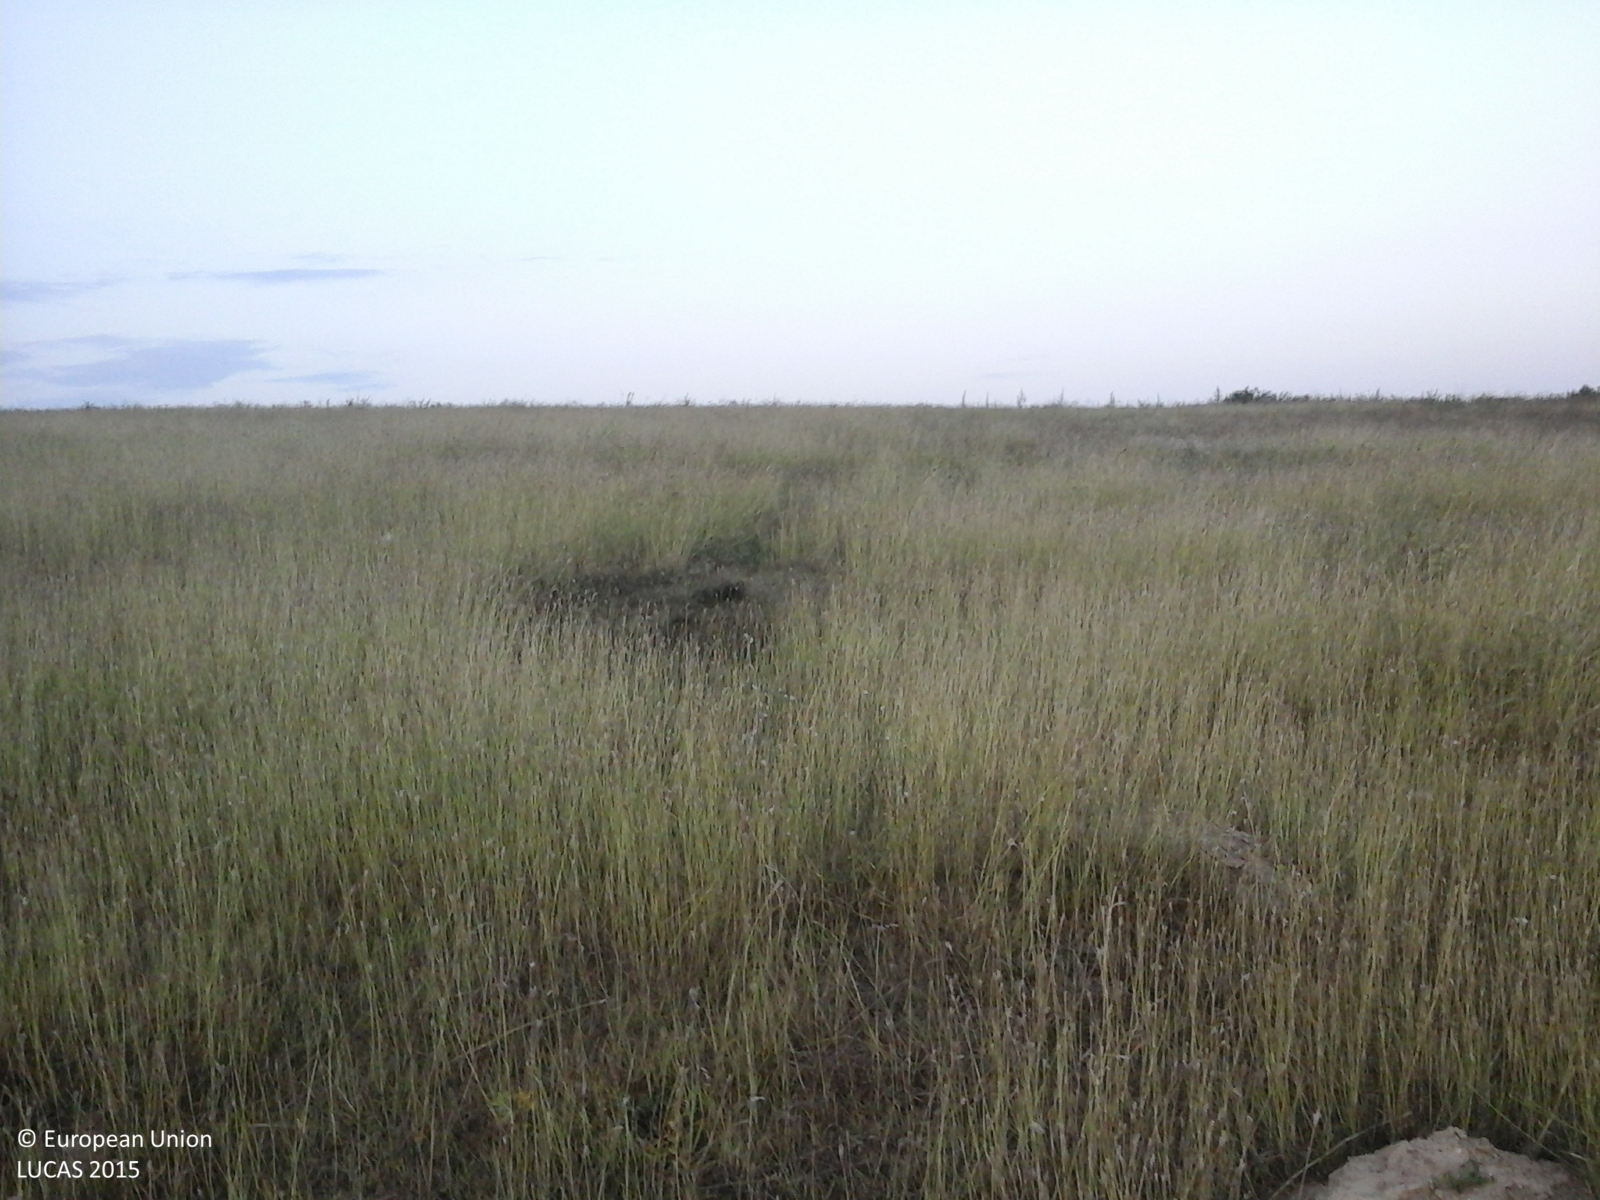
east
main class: Grassland
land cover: Grassland without tree/shrub cover
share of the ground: > 75 %
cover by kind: herbaceous plants 100 %
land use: Agriculture (excluding fallow land and kitchen gardens)
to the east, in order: Grassland without tree/shrub cover; Common wheat; Other bare soil
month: August
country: RO
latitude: 44.2194
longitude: 28.0944
